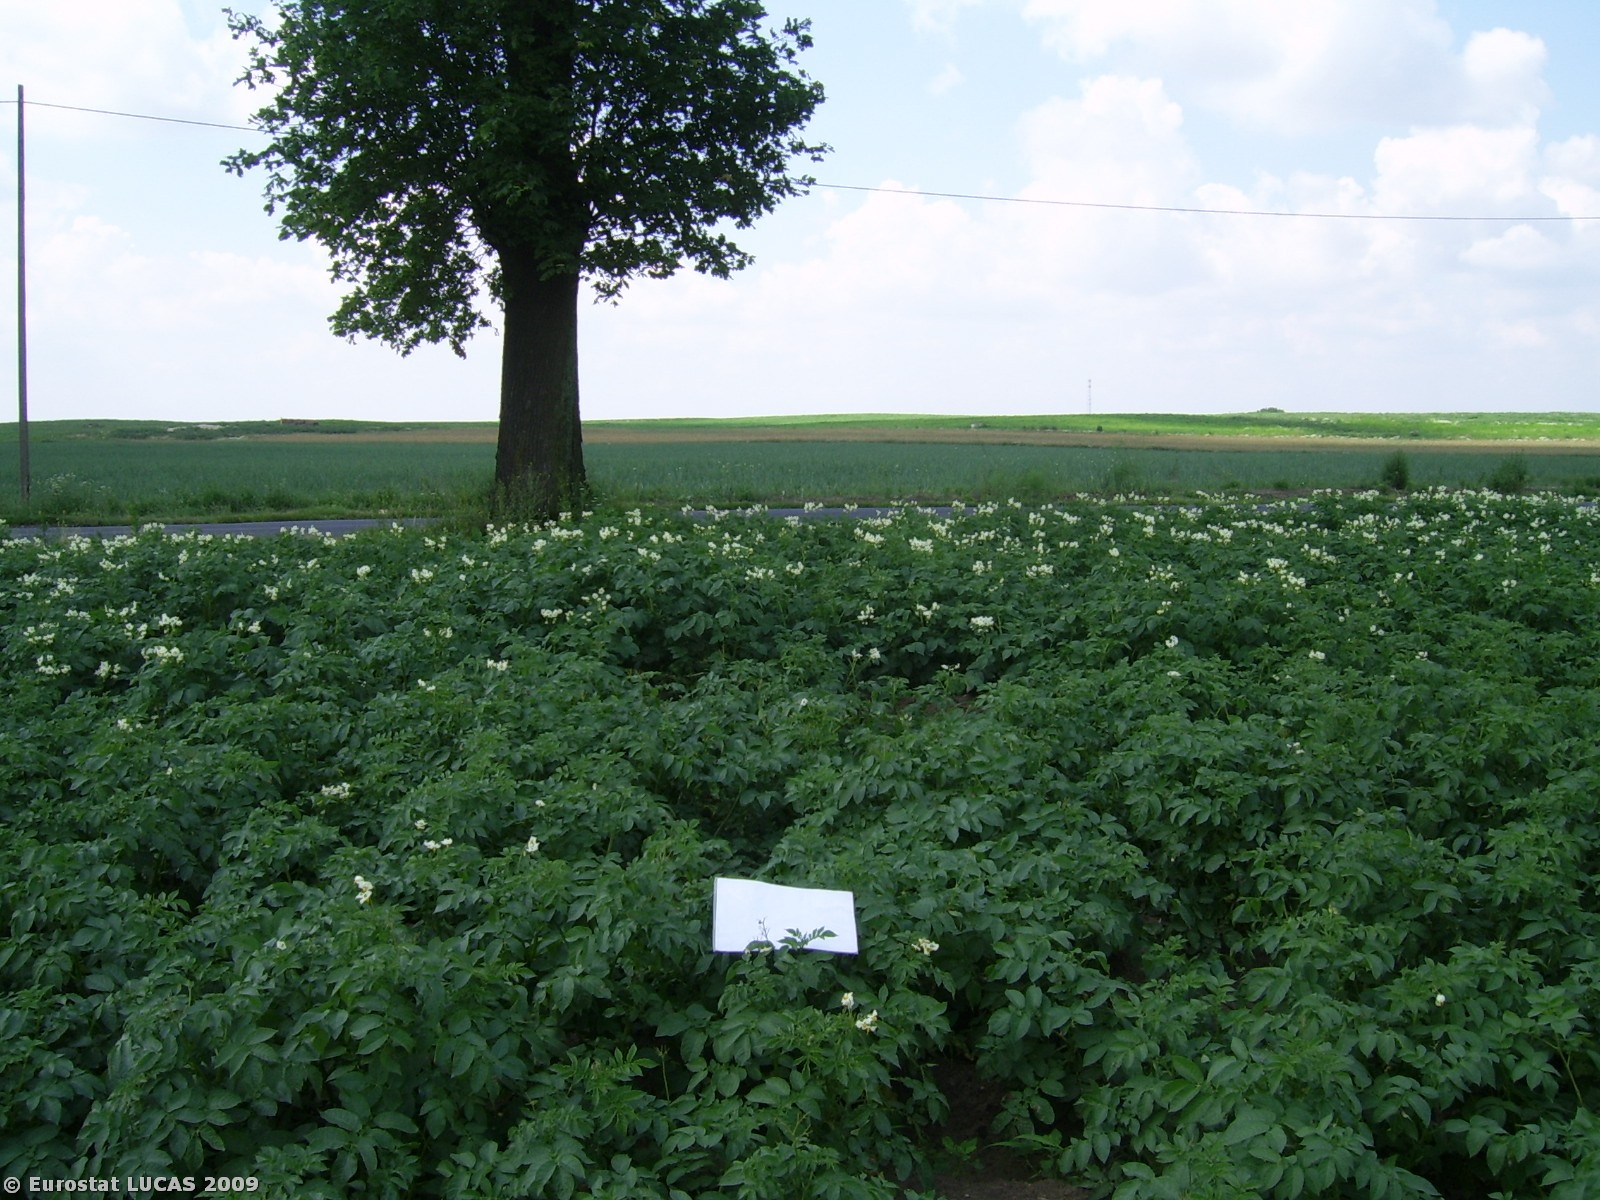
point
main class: Cropland
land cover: Potatoes
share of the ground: > 75 %
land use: Agriculture (excluding fallow land and kitchen gardens)
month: July
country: PL
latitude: 52.6583
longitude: 18.1328
